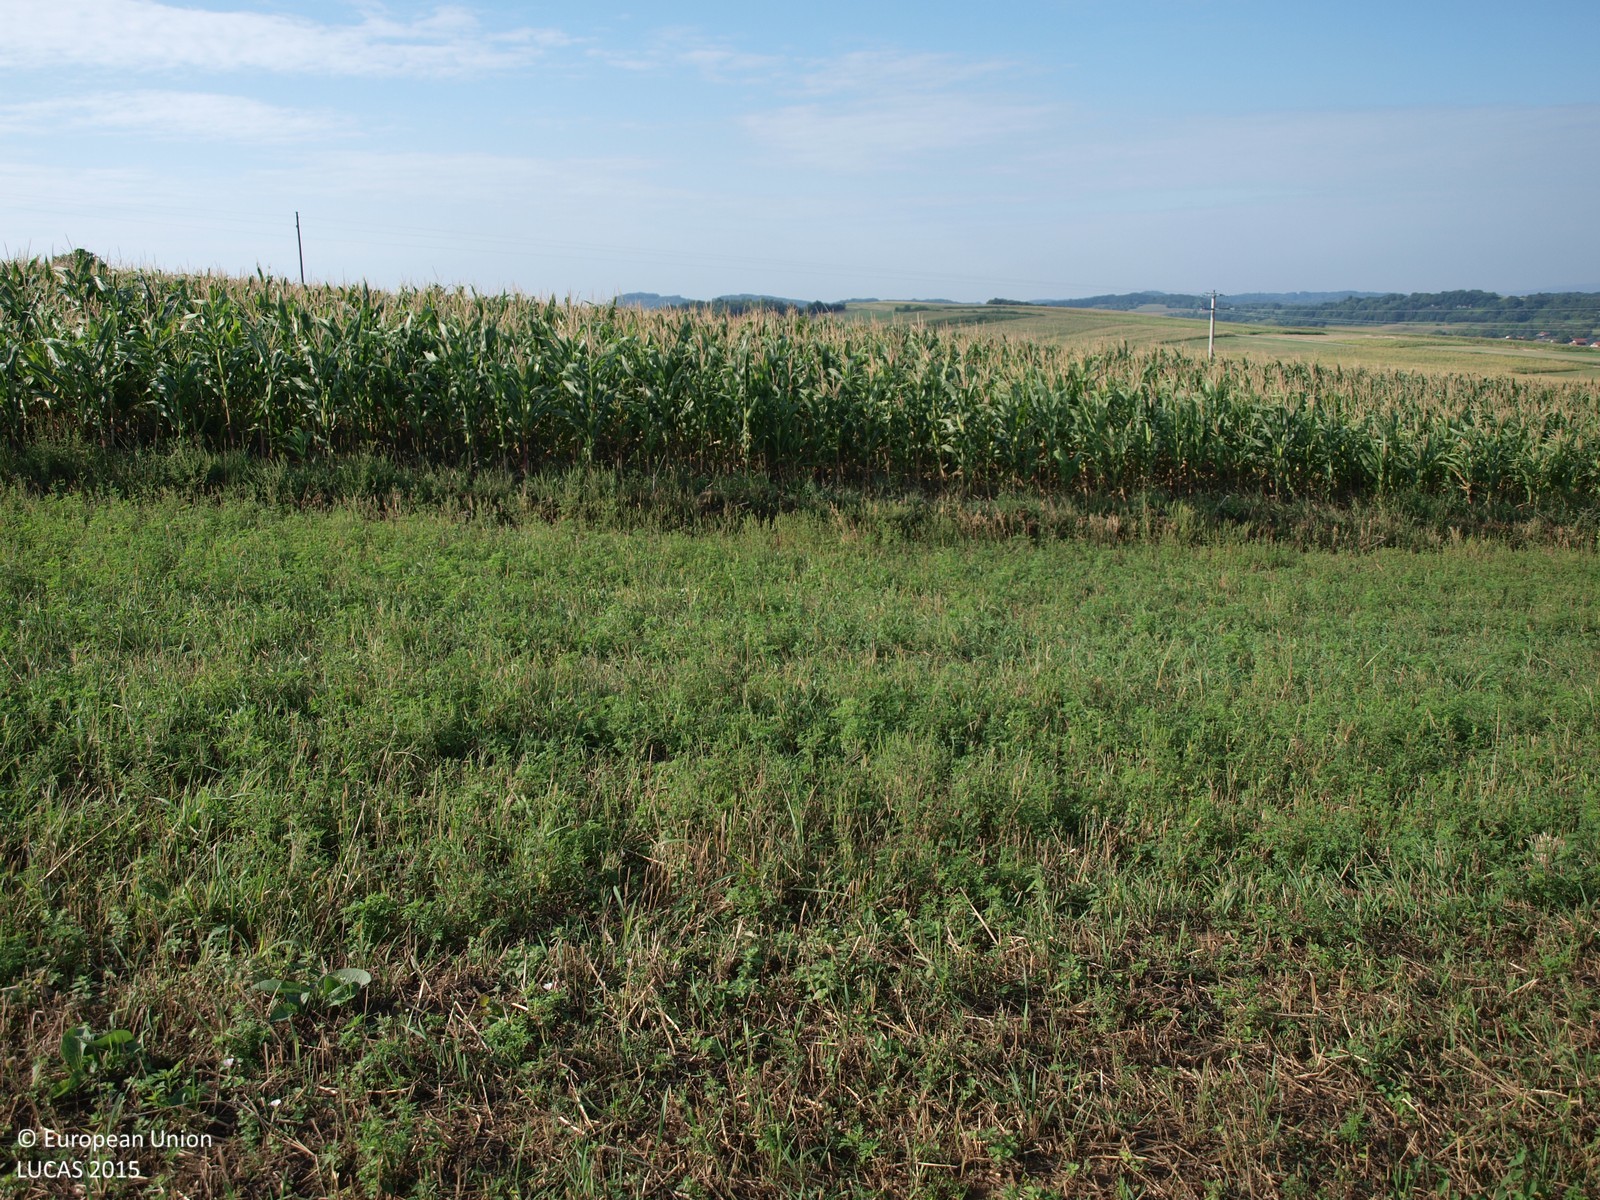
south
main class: Cropland
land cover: Oats
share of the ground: > 75 %
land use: Agriculture (excluding fallow land and kitchen gardens)
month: August
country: HR
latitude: 46.1051
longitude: 16.4035
